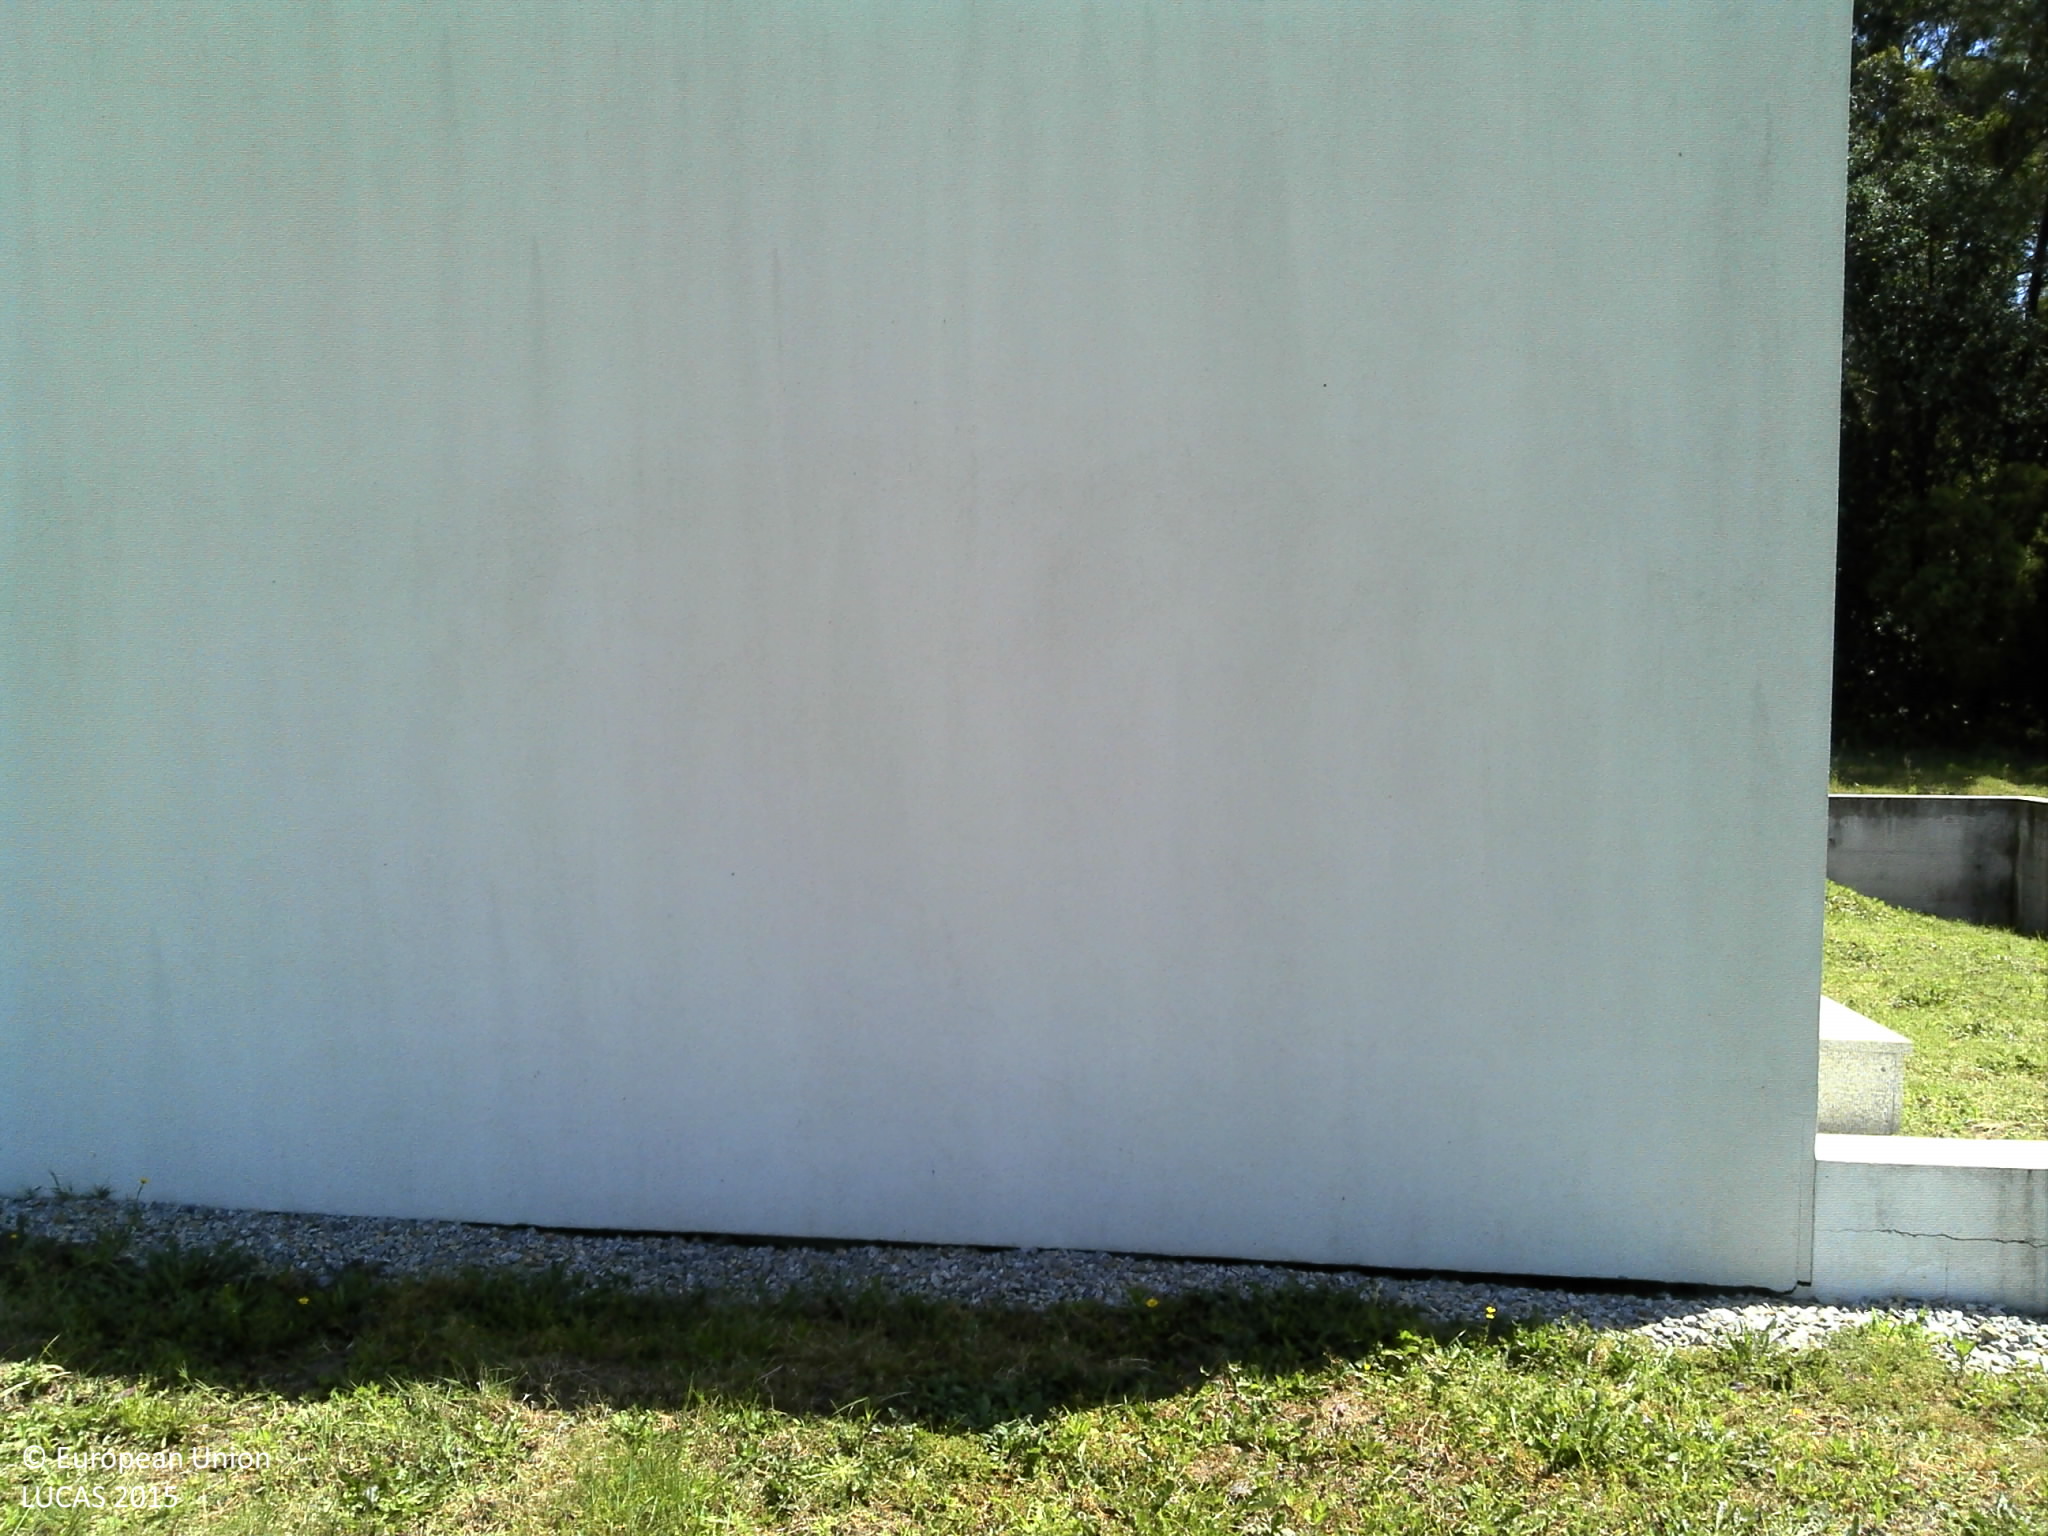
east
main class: Grassland
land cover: Grassland without tree/shrub cover
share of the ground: 50 - 75 %
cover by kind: herbaceous plants 75 %, consolidated bare surface 25 %
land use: Agriculture (excluding fallow land and kitchen gardens)
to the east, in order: Grassland without tree/shrub cover; Artificial constructions in urban areas; Grassland without tree/shrub cover; Broadleaved woodland; Tracks; Broadleaved woodland; Tracks; Broadleaved woodland; Maize; Vineyards; Temporary grasslands
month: May
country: PT
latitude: 41.3788
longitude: -8.4831
